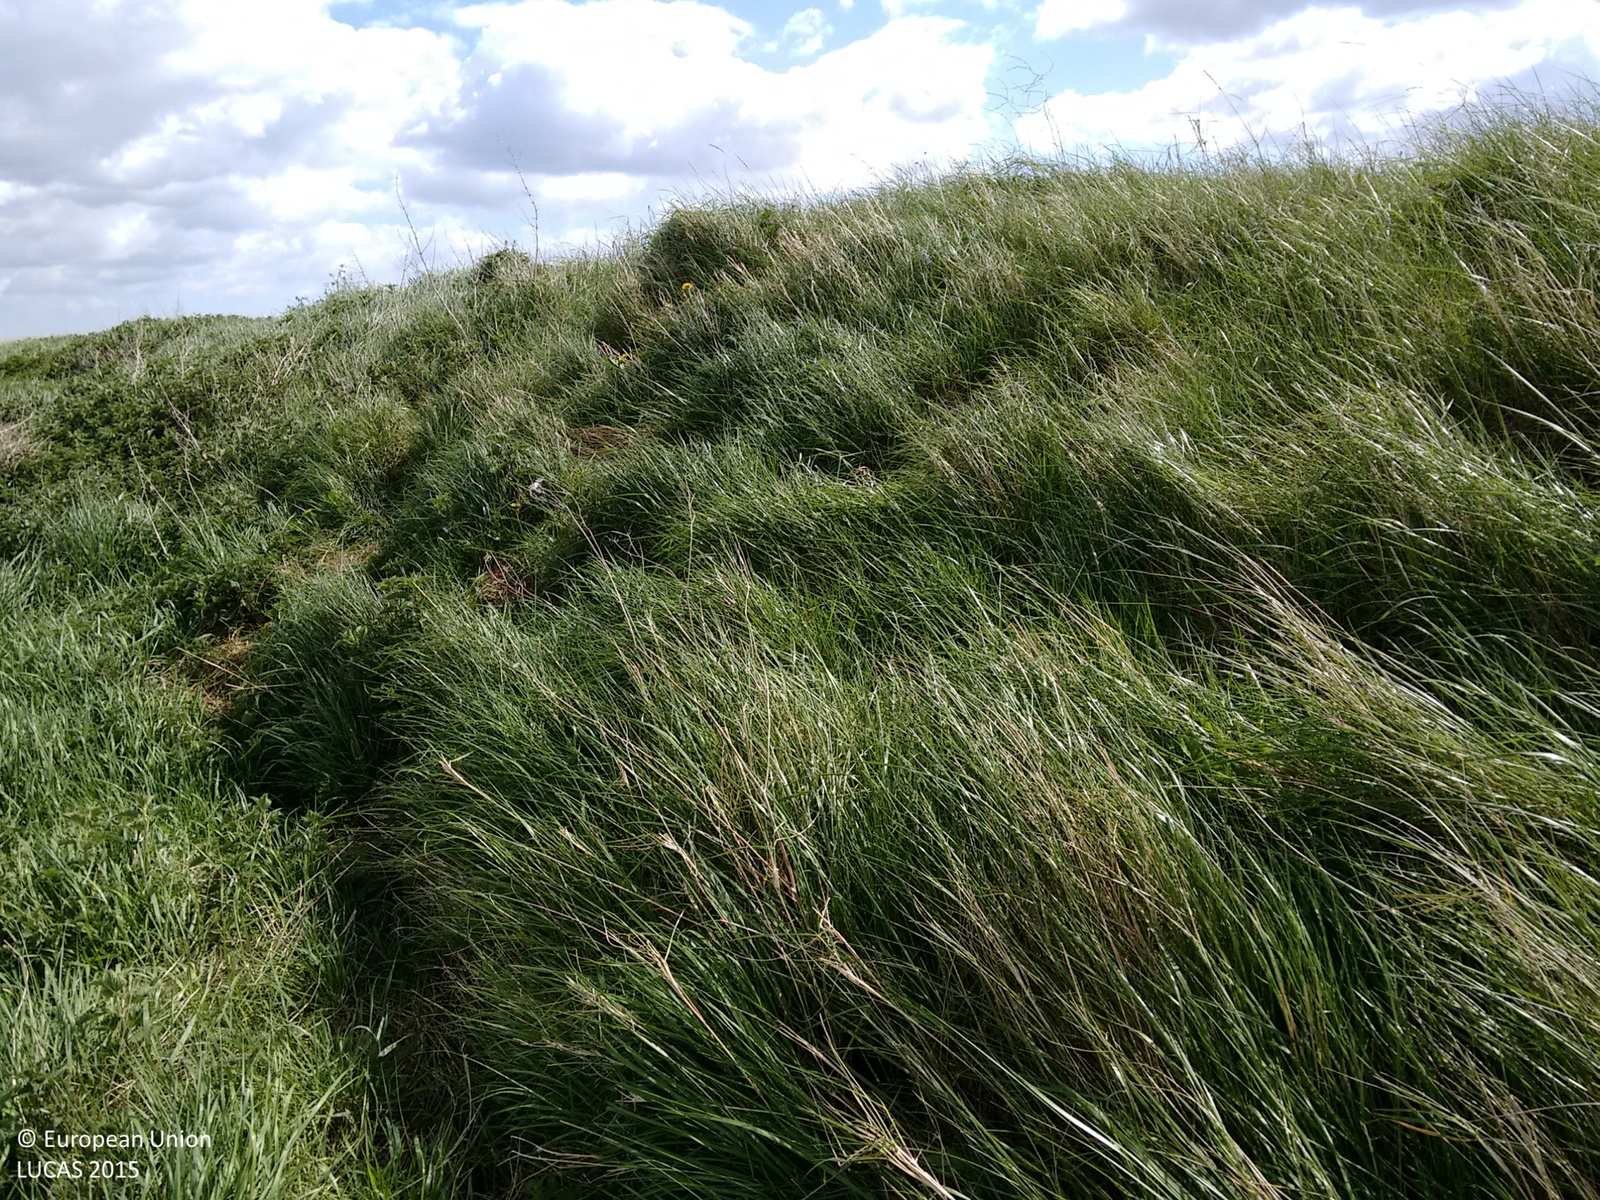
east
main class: Grassland
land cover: Grassland without tree/shrub cover
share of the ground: > 75 %
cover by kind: herbaceous plants 100 %
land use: Semi-natural and natural areas not in use
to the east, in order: Grassland without tree/shrub cover; Potatoes
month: May
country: GB
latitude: 53.0803
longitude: 0.2521
